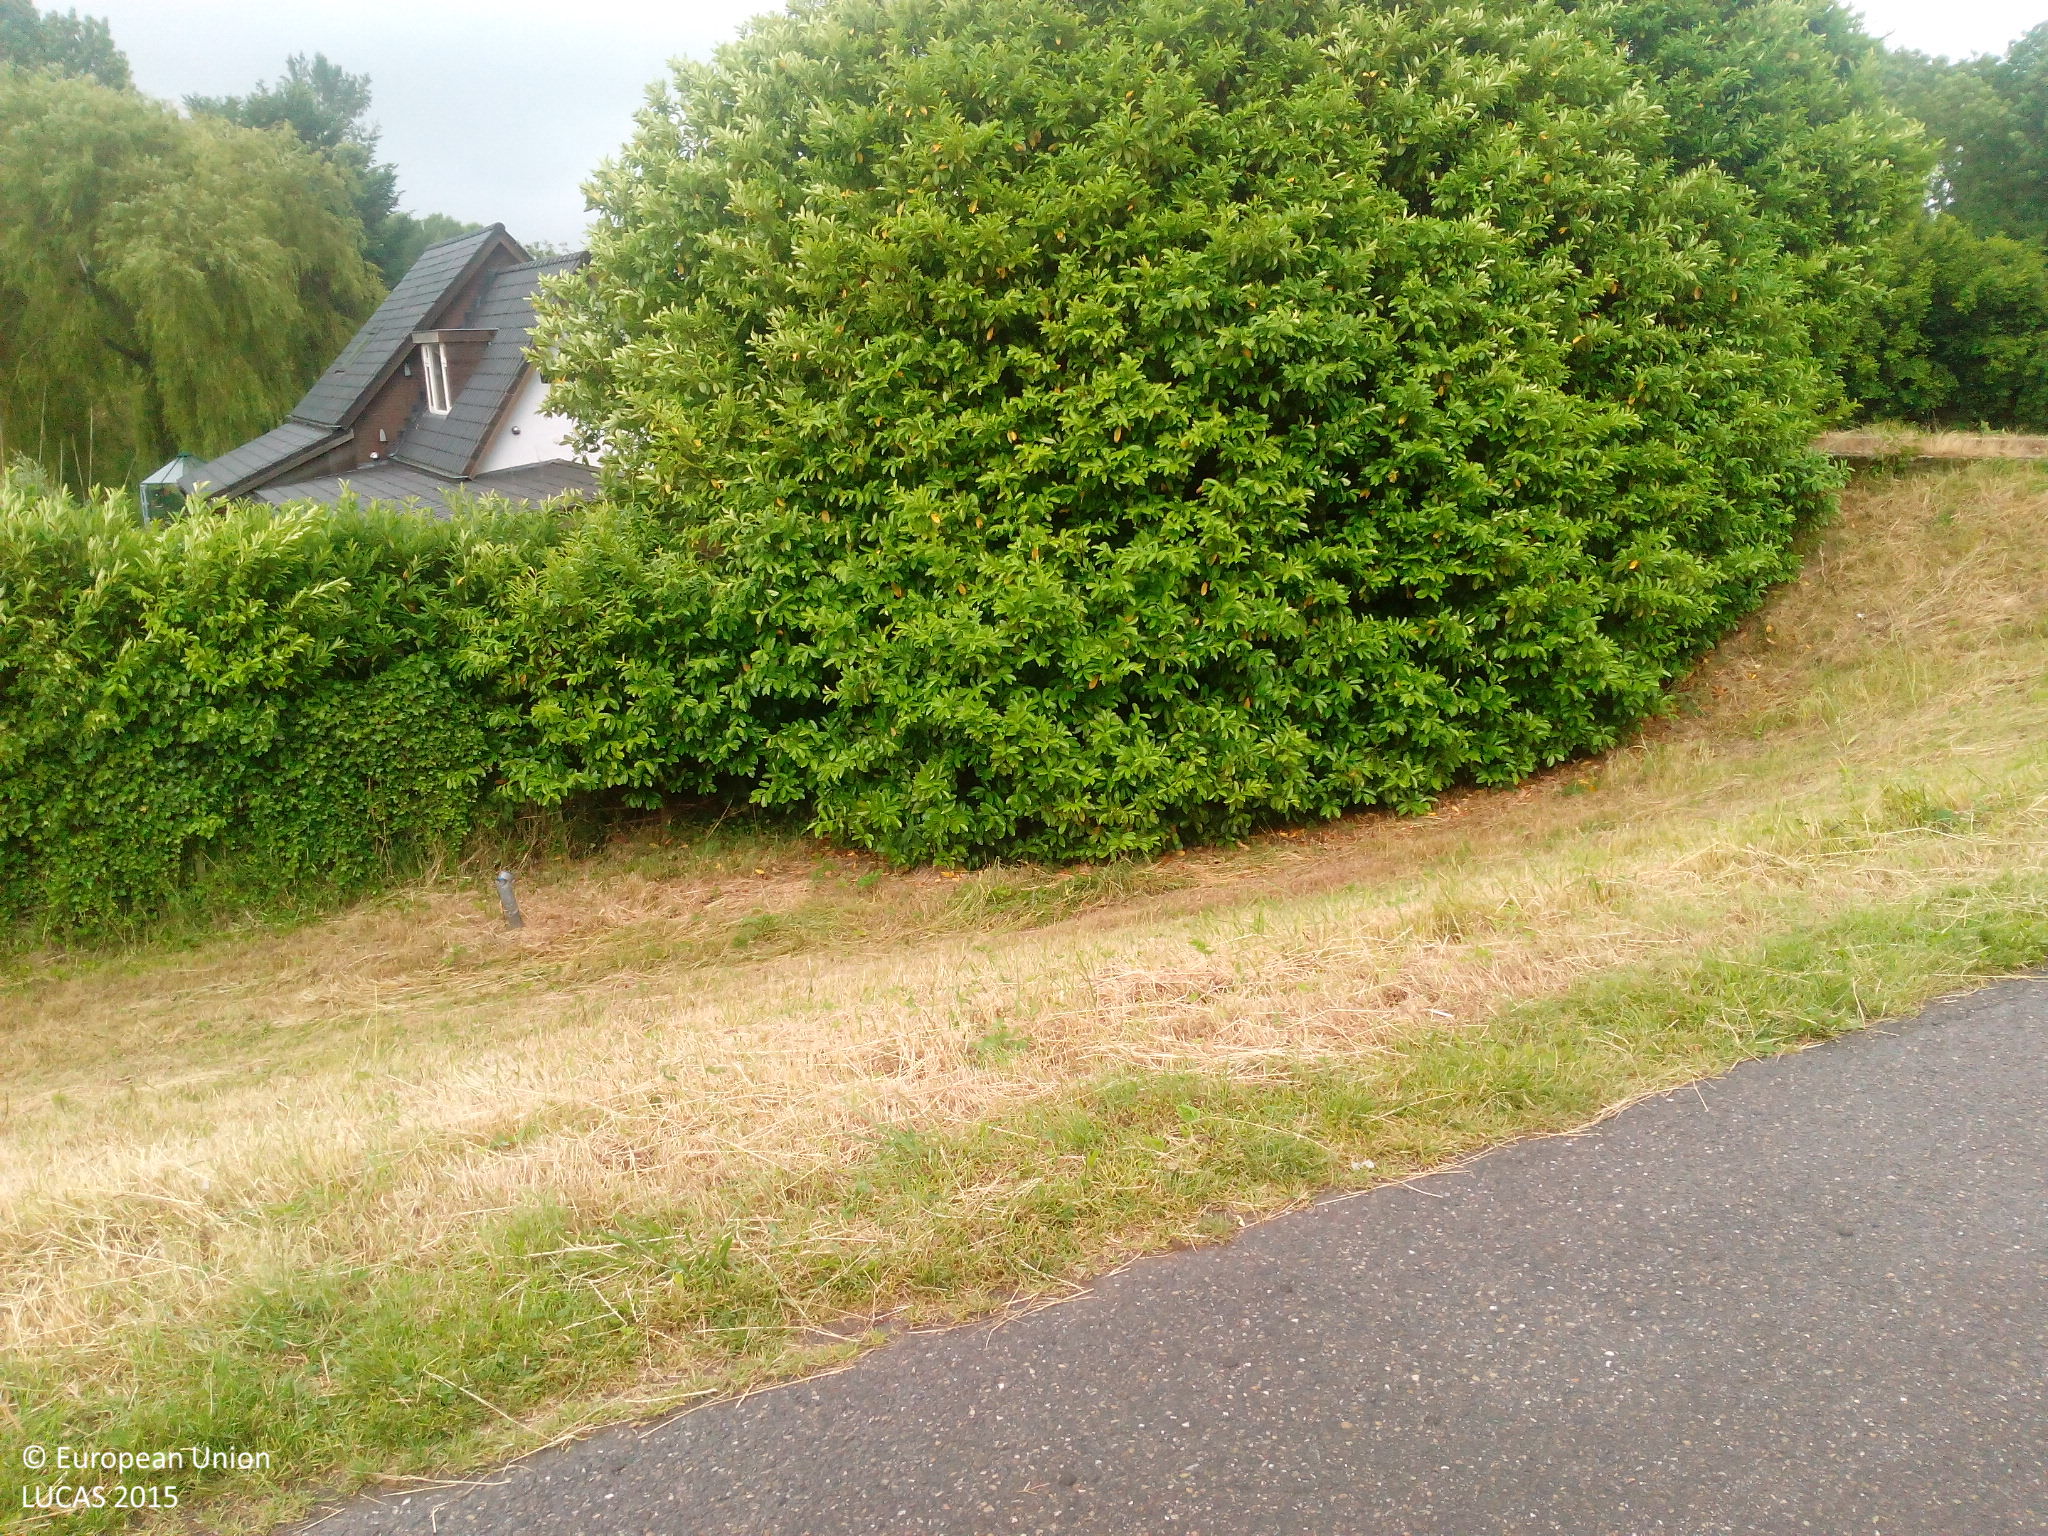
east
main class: Woodland
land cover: Broadleaved woodland
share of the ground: > 75 %
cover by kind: broadleaved forest trees 90 %, herbaceous plants 10 %
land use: Semi-natural and natural areas not in use
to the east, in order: Broadleaved woodland; Spontaneously vegetated surfaces; Inland fresh running water; Broadleaved woodland; Spontaneously vegetated surfaces; Broadleaved woodland
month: June
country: NL
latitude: 51.7538
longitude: 4.6799
